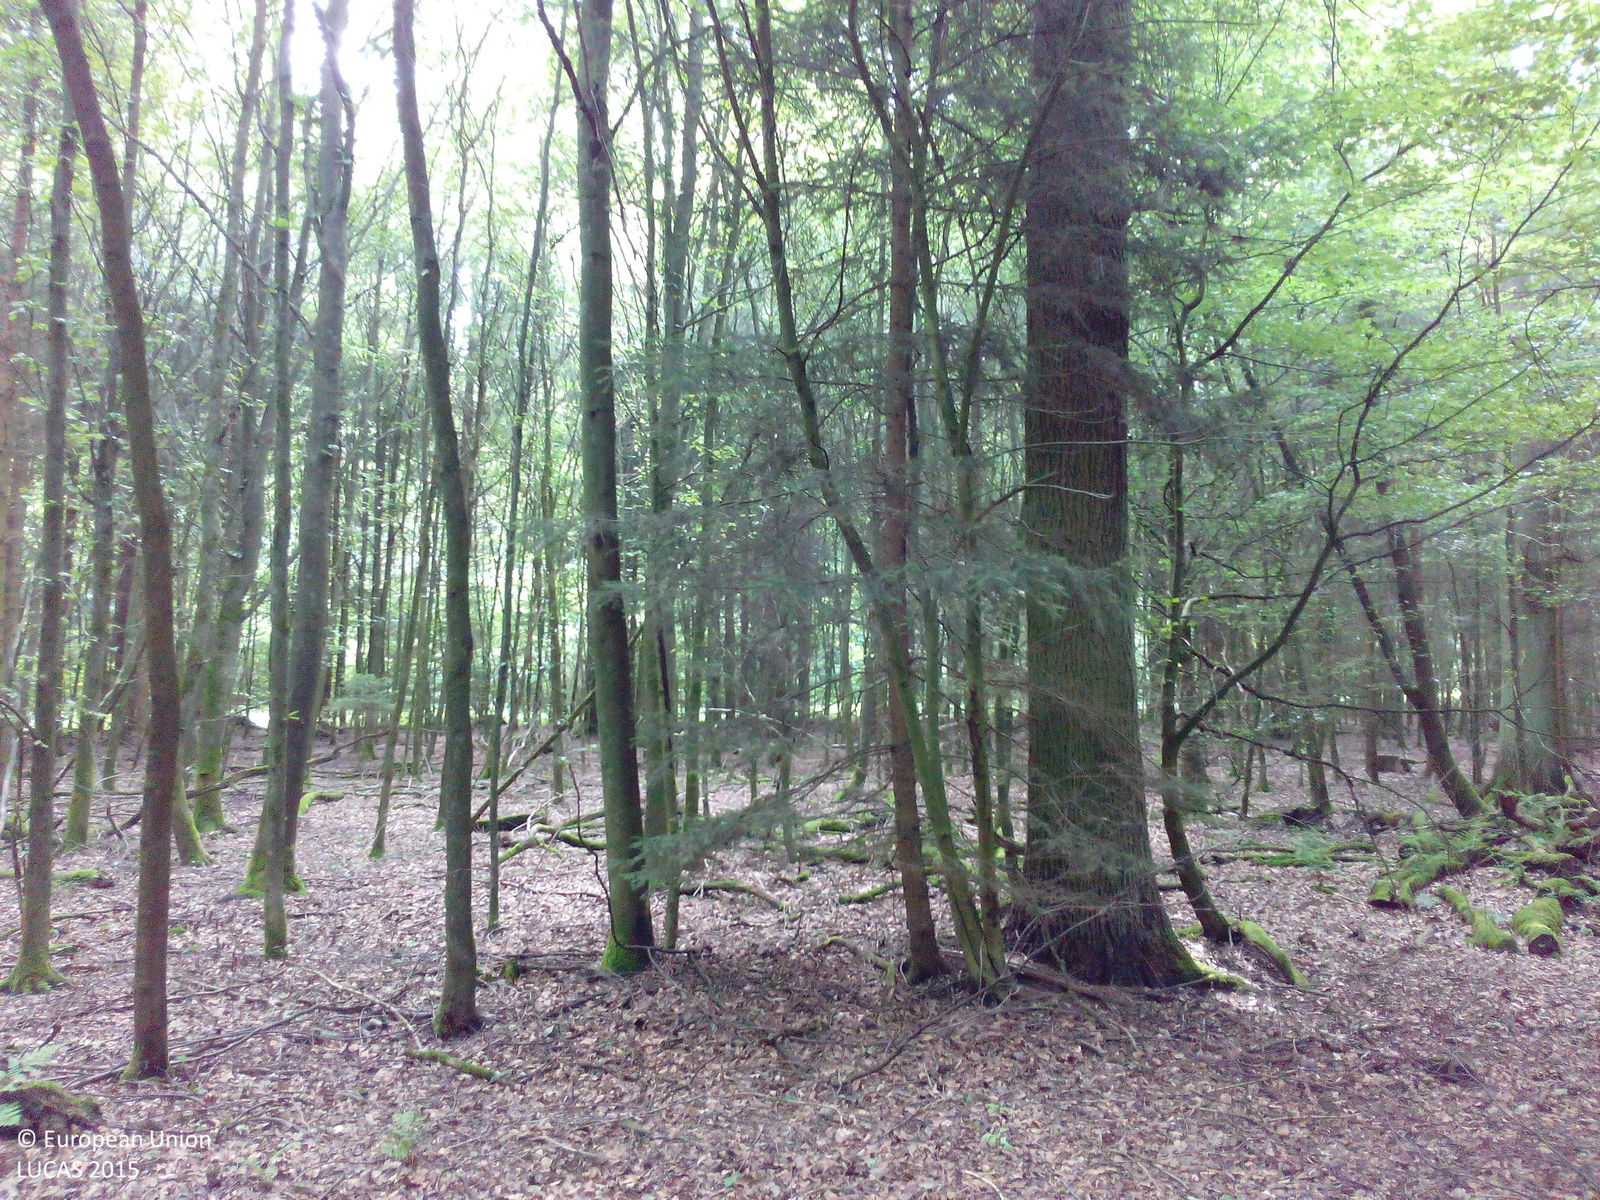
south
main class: Woodland
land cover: Broadleaved woodland
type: beech forest
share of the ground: > 75 %
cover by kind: broadleaved forest trees 95 %, coniferous forest trees 5 %
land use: Forestry
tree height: > 5 m
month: July
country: DE
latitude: 51.4782
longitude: 9.6689
